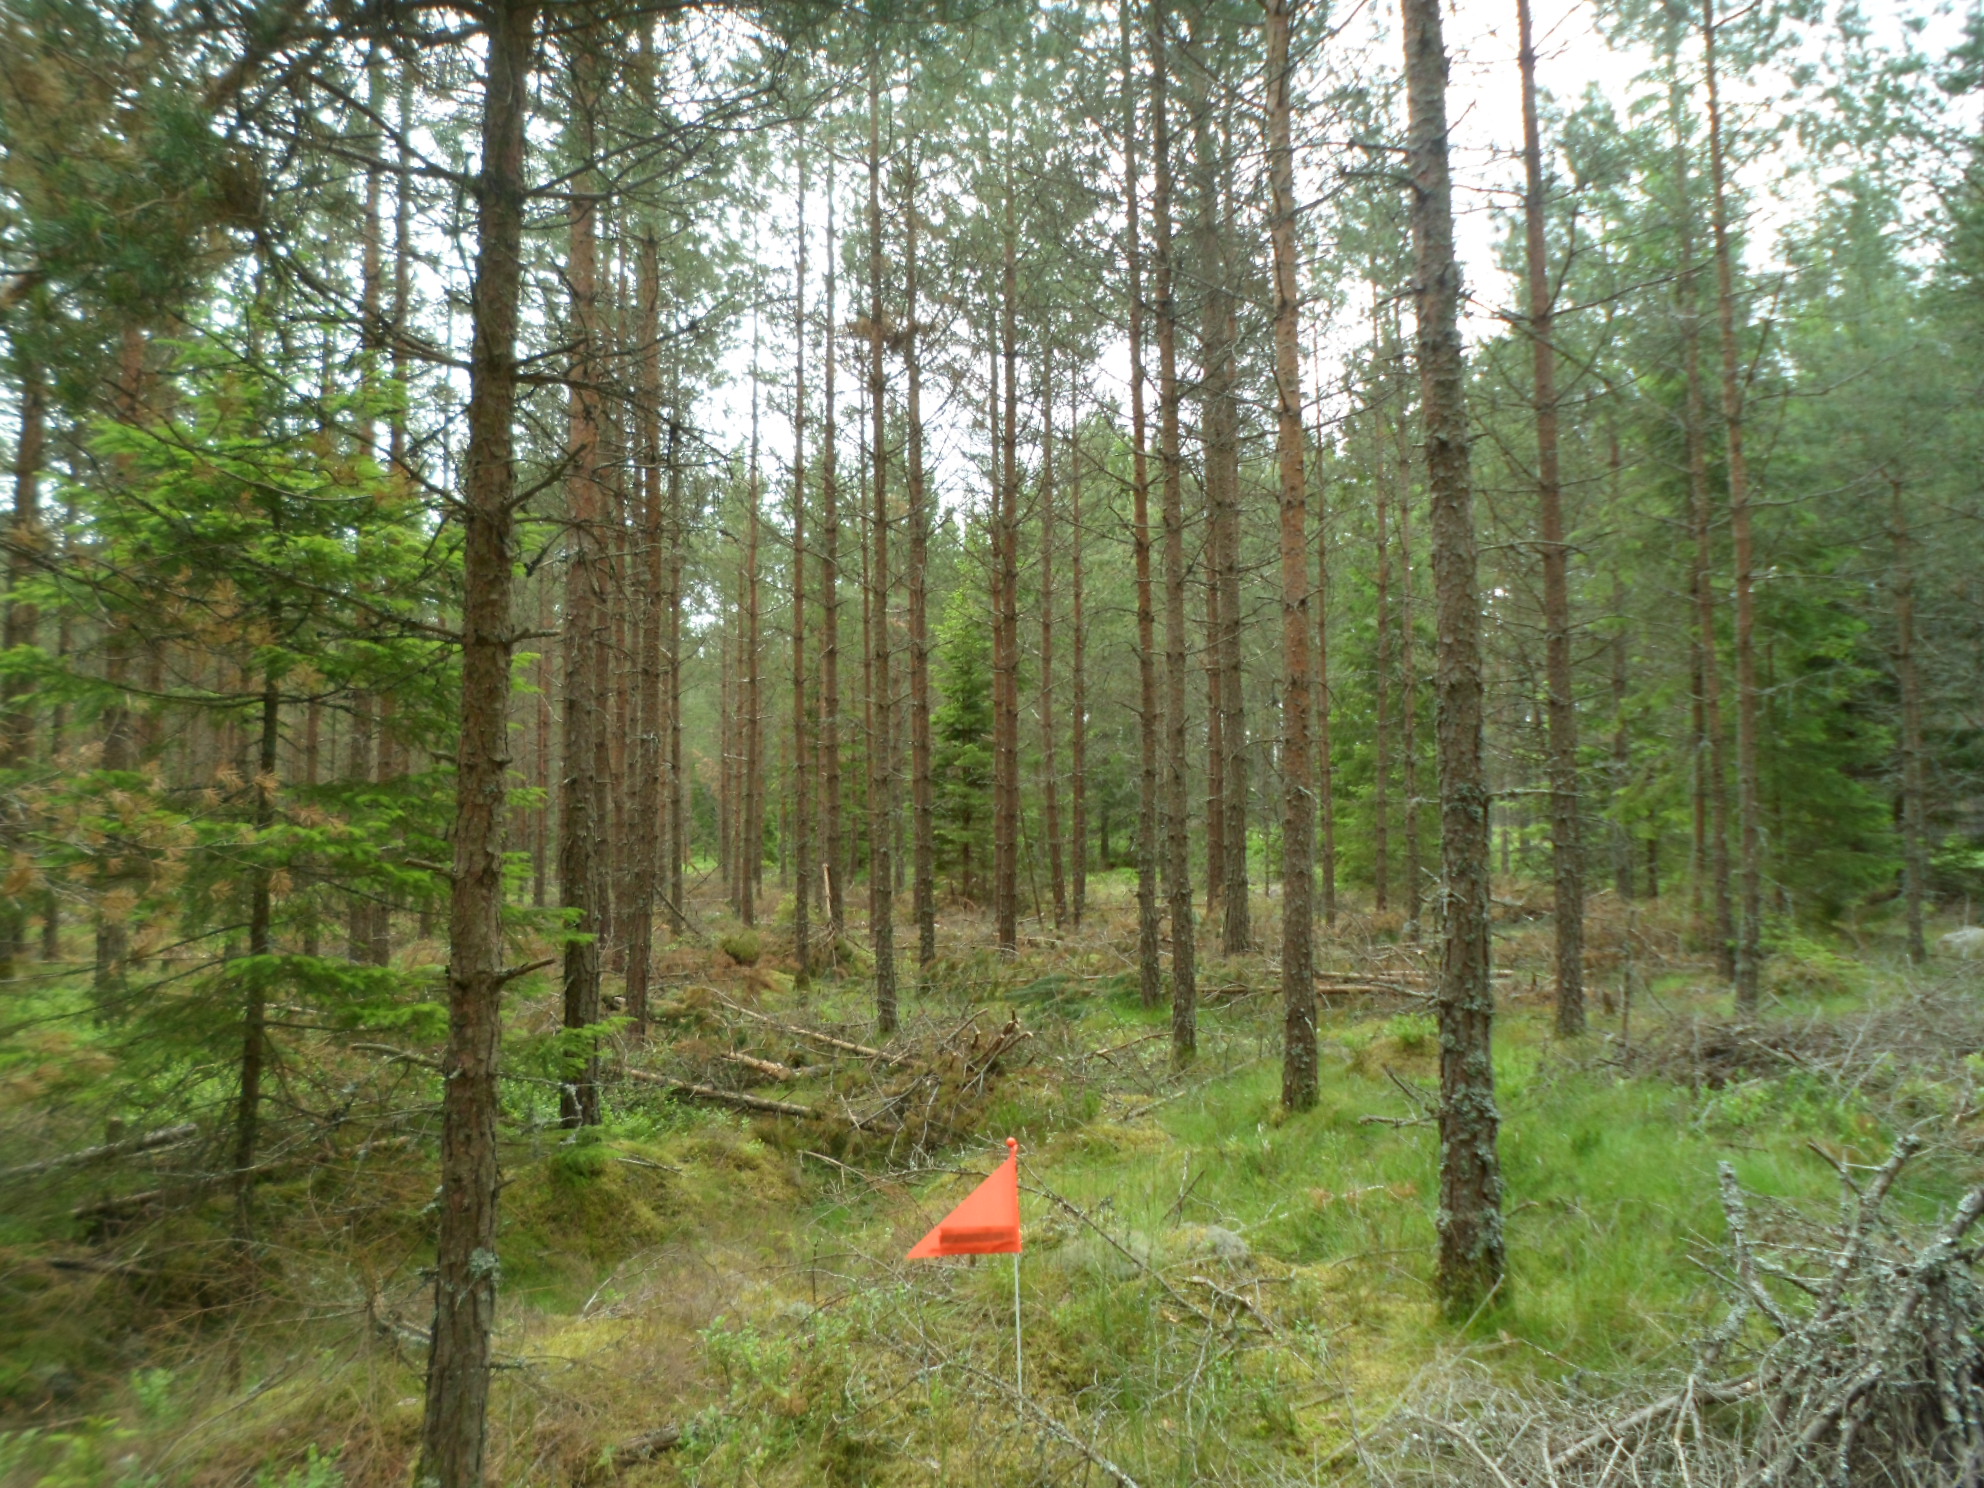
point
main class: Woodland
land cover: Pine dominated coniferous woodland
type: boreal forest
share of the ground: 50 - 75 %
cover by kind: coniferous forest trees 50 %, shrubs 20 %, lichens and mosses 20 %, herbaceous plants 10 %
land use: Forestry
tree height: > 5 m
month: June
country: SE
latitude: 56.9623
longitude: 15.2768
